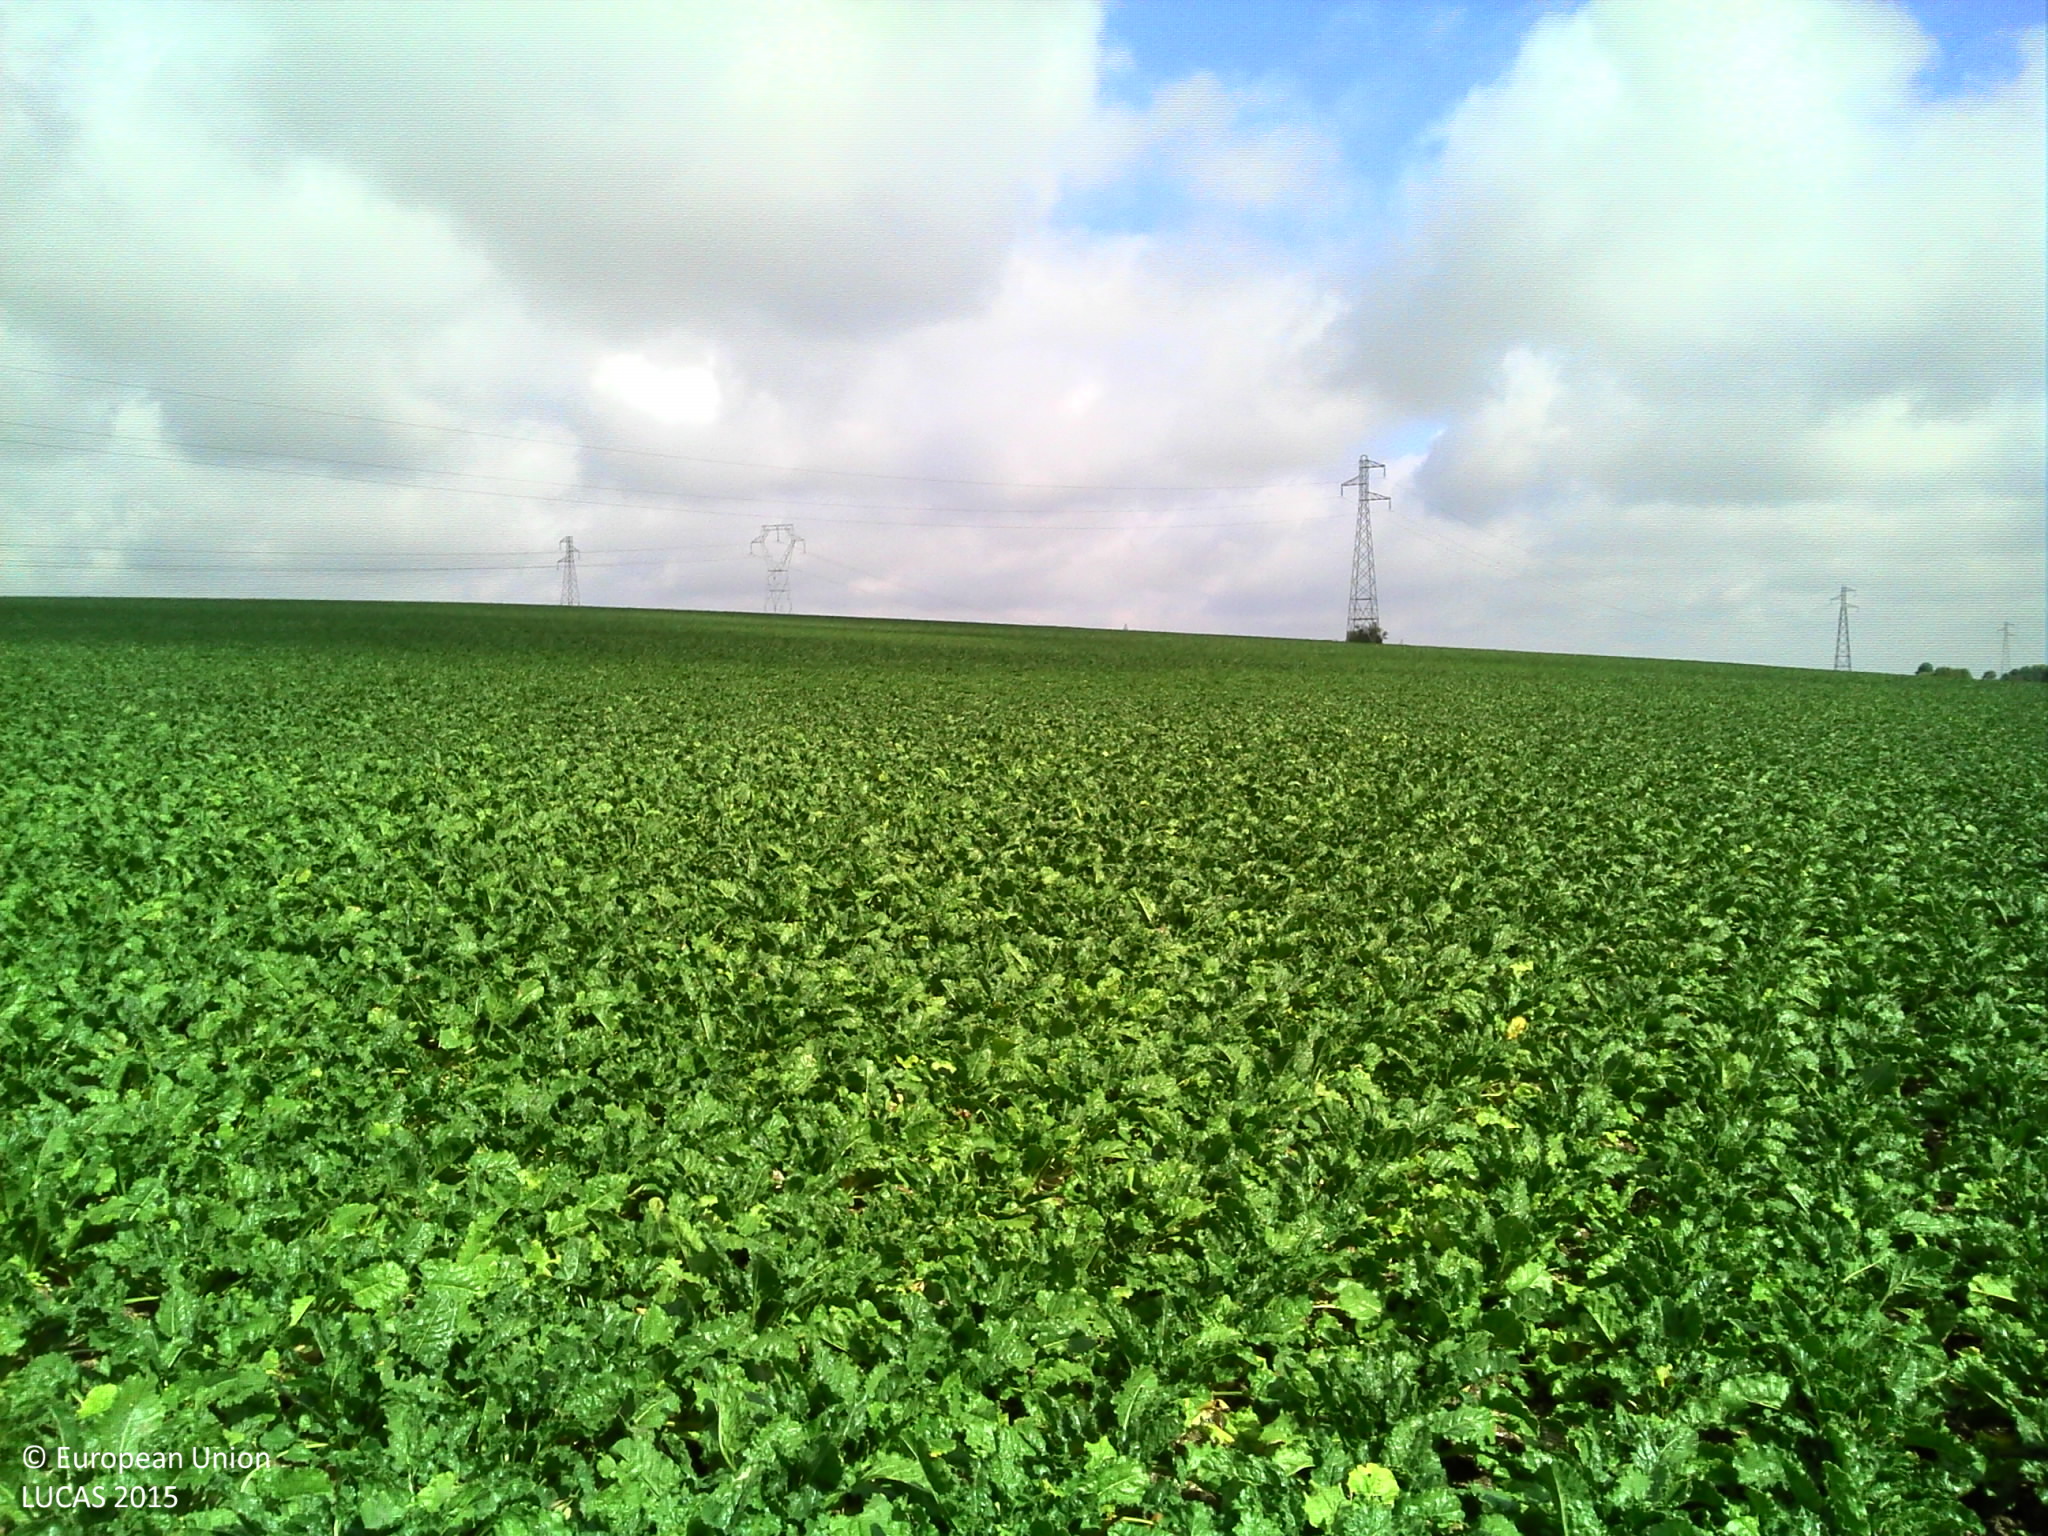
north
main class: Cropland
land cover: Sugar beet
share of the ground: > 75 %
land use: Agriculture (excluding fallow land and kitchen gardens)
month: September
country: FR
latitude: 48.3792
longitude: 4.2315
